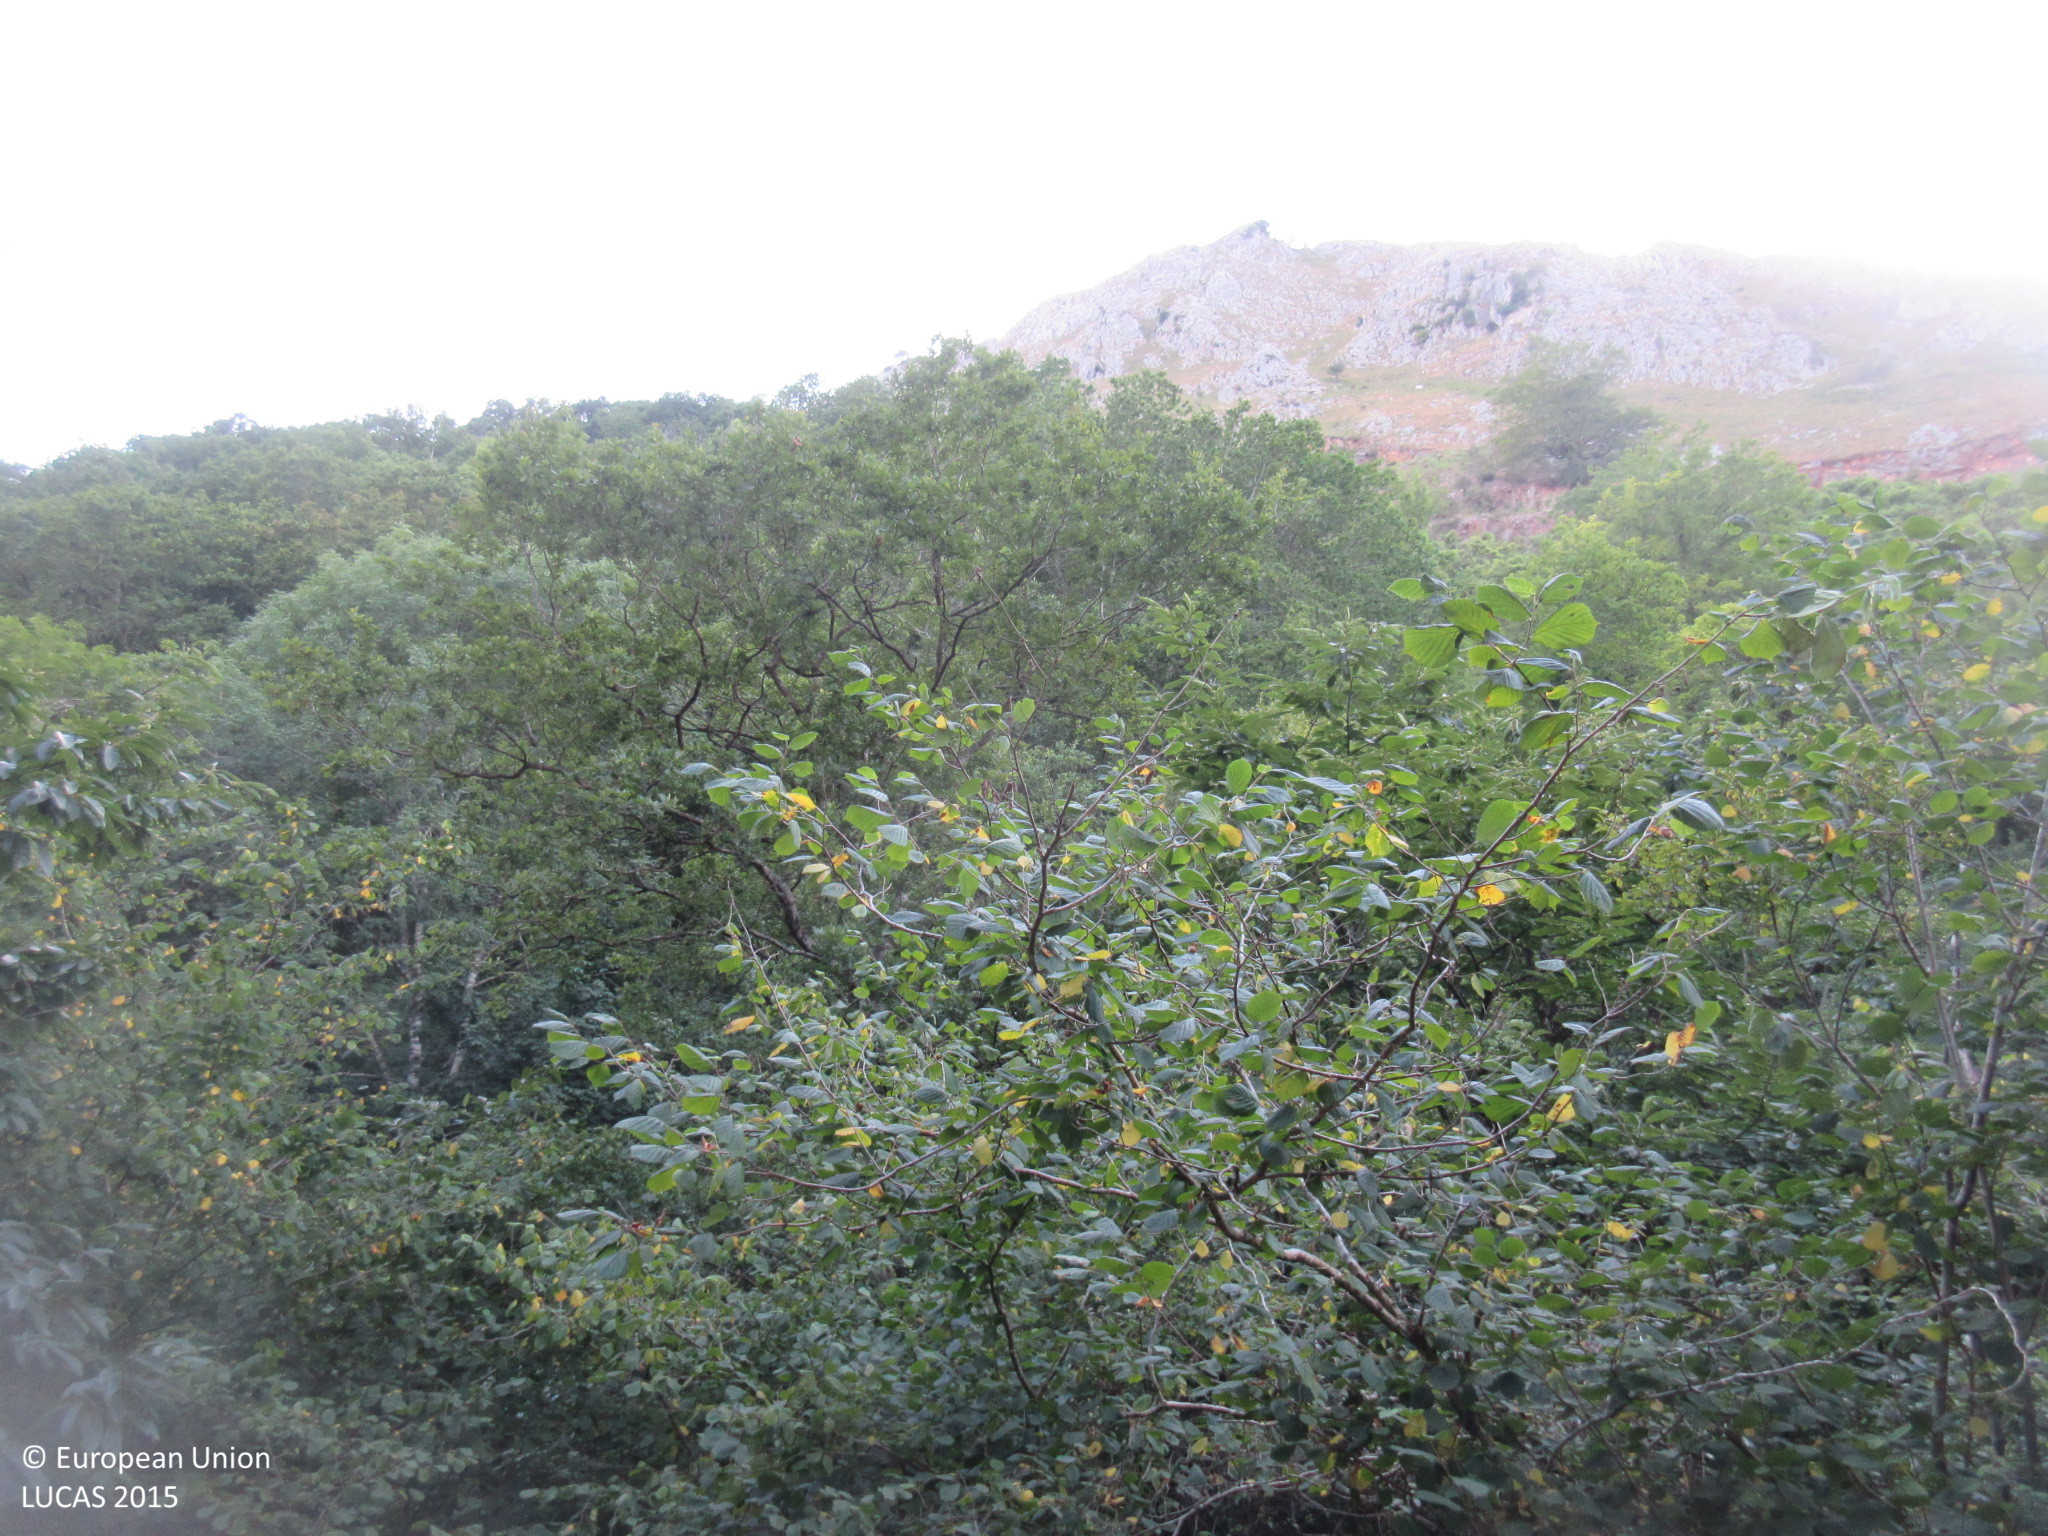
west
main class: Grassland
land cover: Grassland without tree/shrub cover
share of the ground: > 75 %
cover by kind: herbaceous plants 80 %, consolidated bare surface 20 %
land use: Agriculture (excluding fallow land and kitchen gardens)
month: July
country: ES
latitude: 43.3854
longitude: -5.0947
